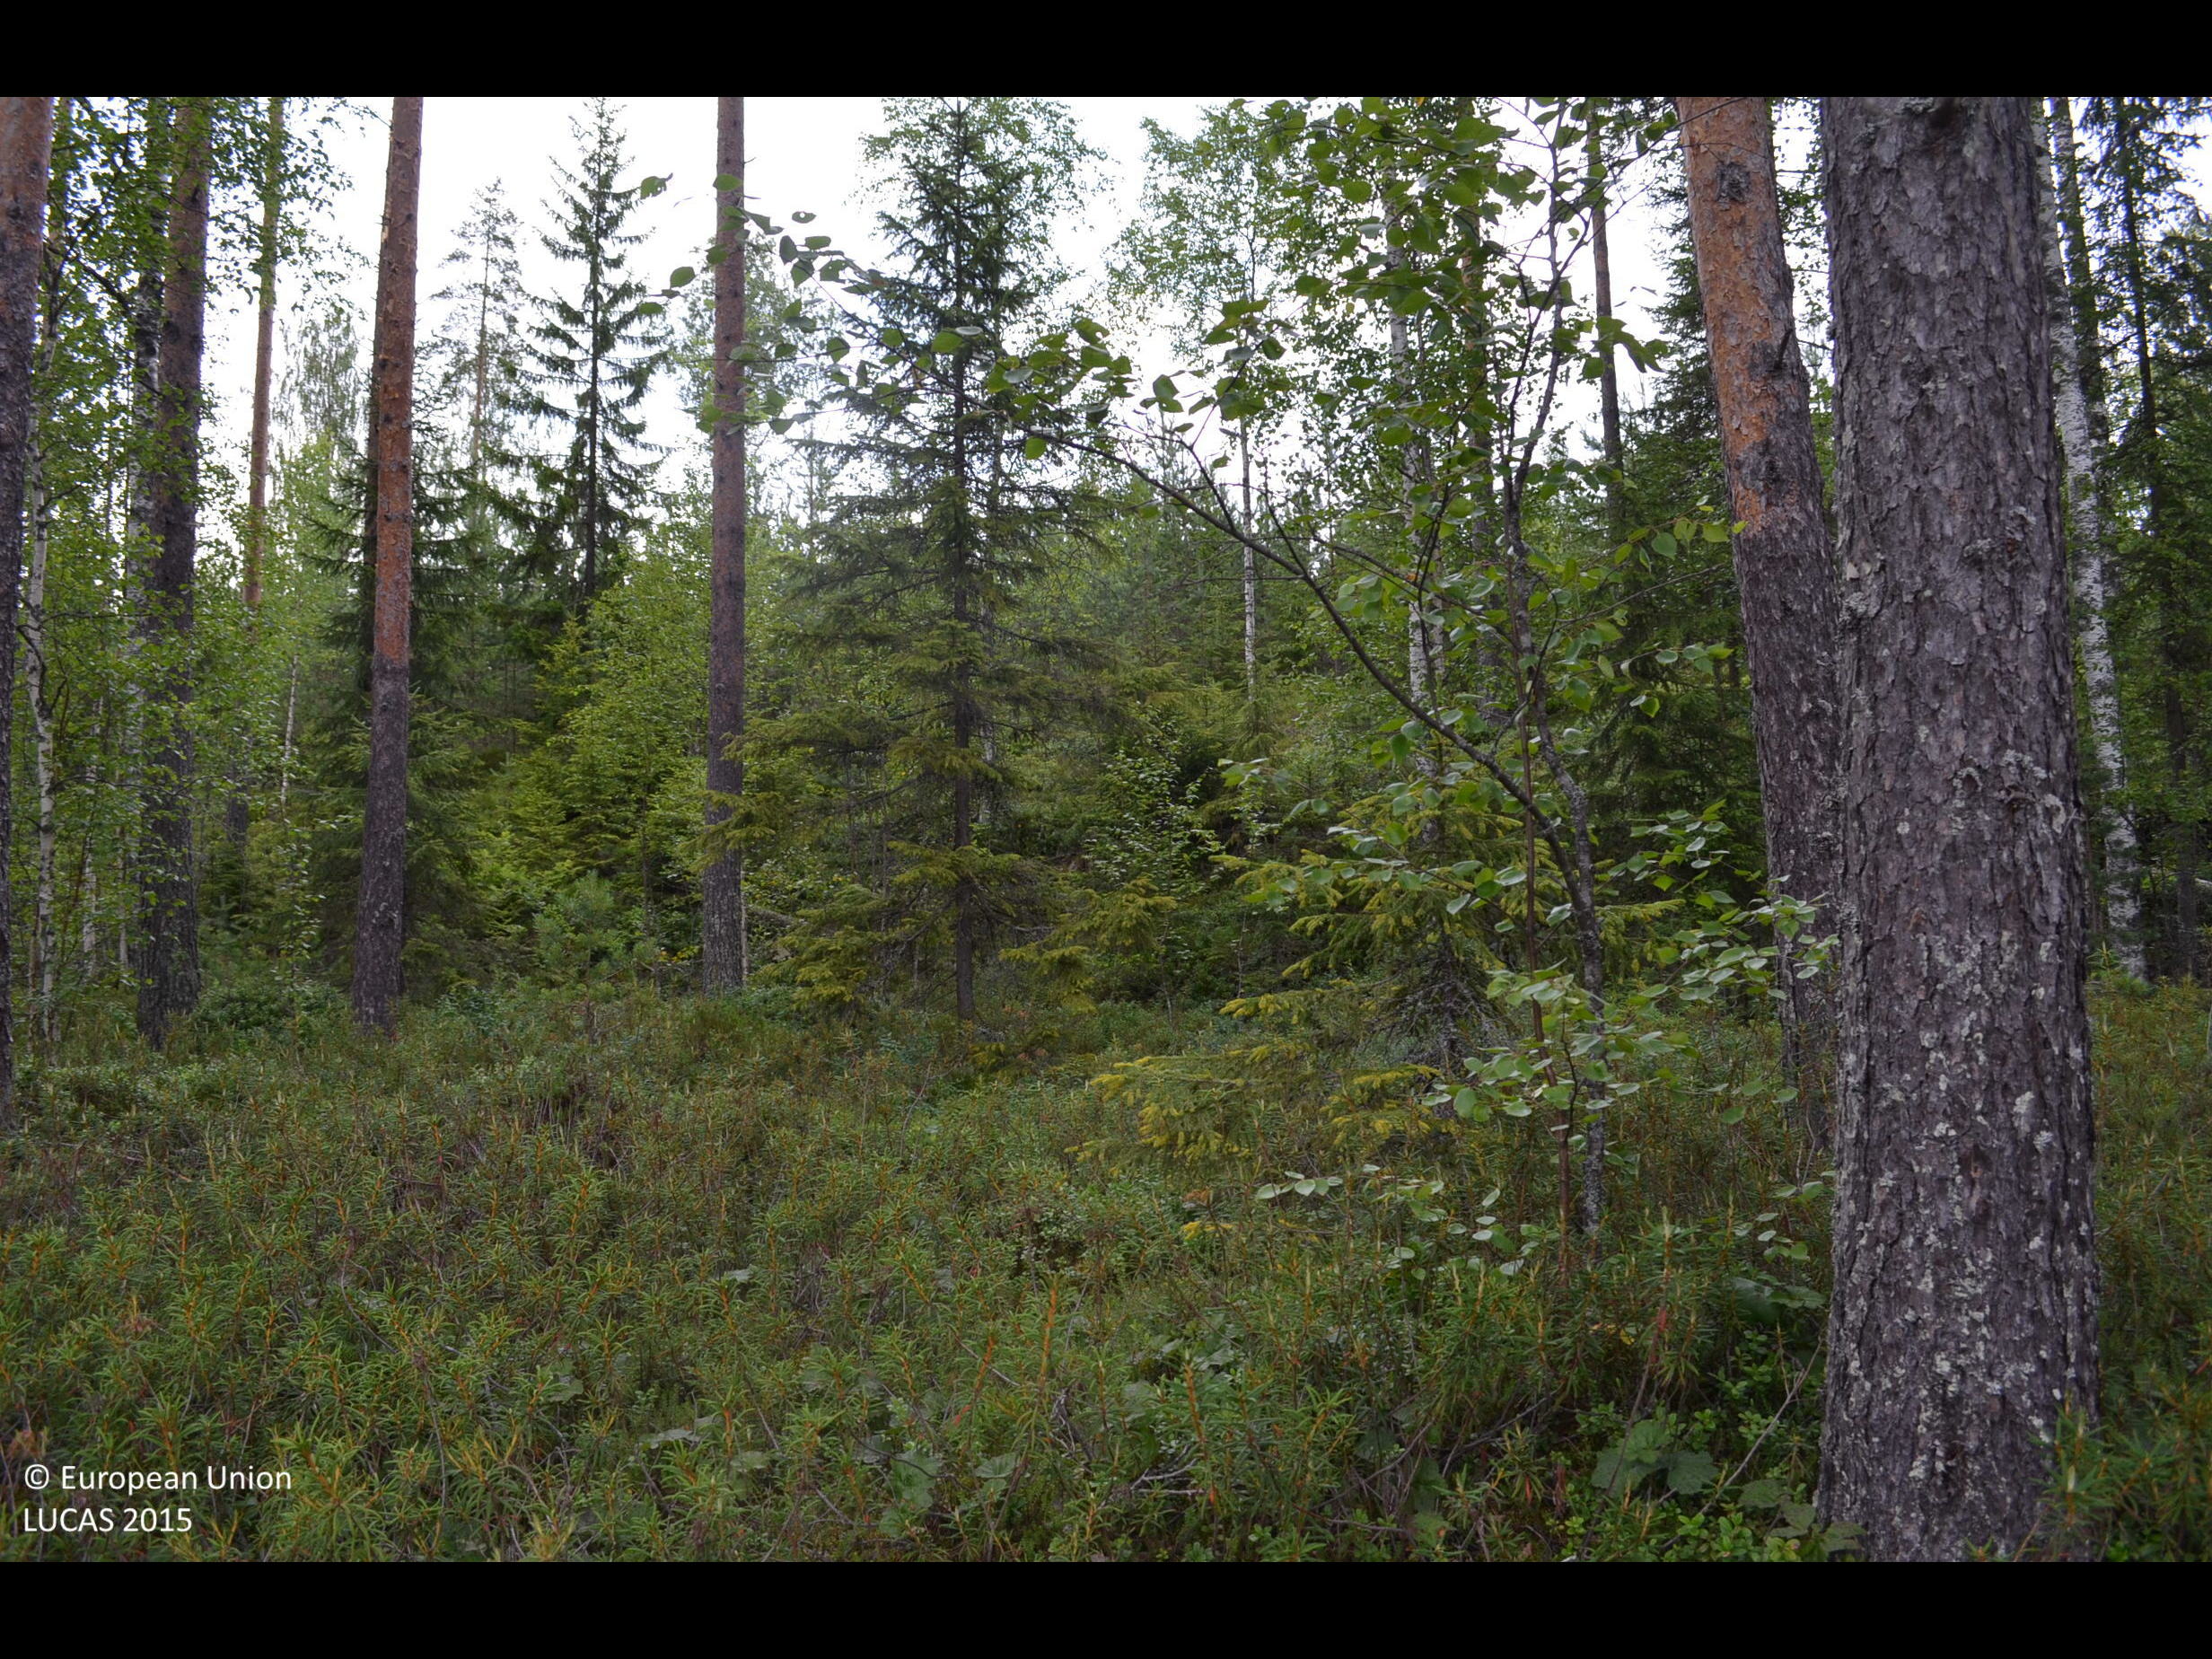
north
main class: Woodland
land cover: Pine dominated coniferous woodland
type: boreal forest
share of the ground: > 75 %
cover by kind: coniferous forest trees 65 %, shrubs 25 %, broadleaved forest trees 10 %
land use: Forestry
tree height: > 5 m
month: July
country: FI
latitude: 62.0294
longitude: 23.9783
